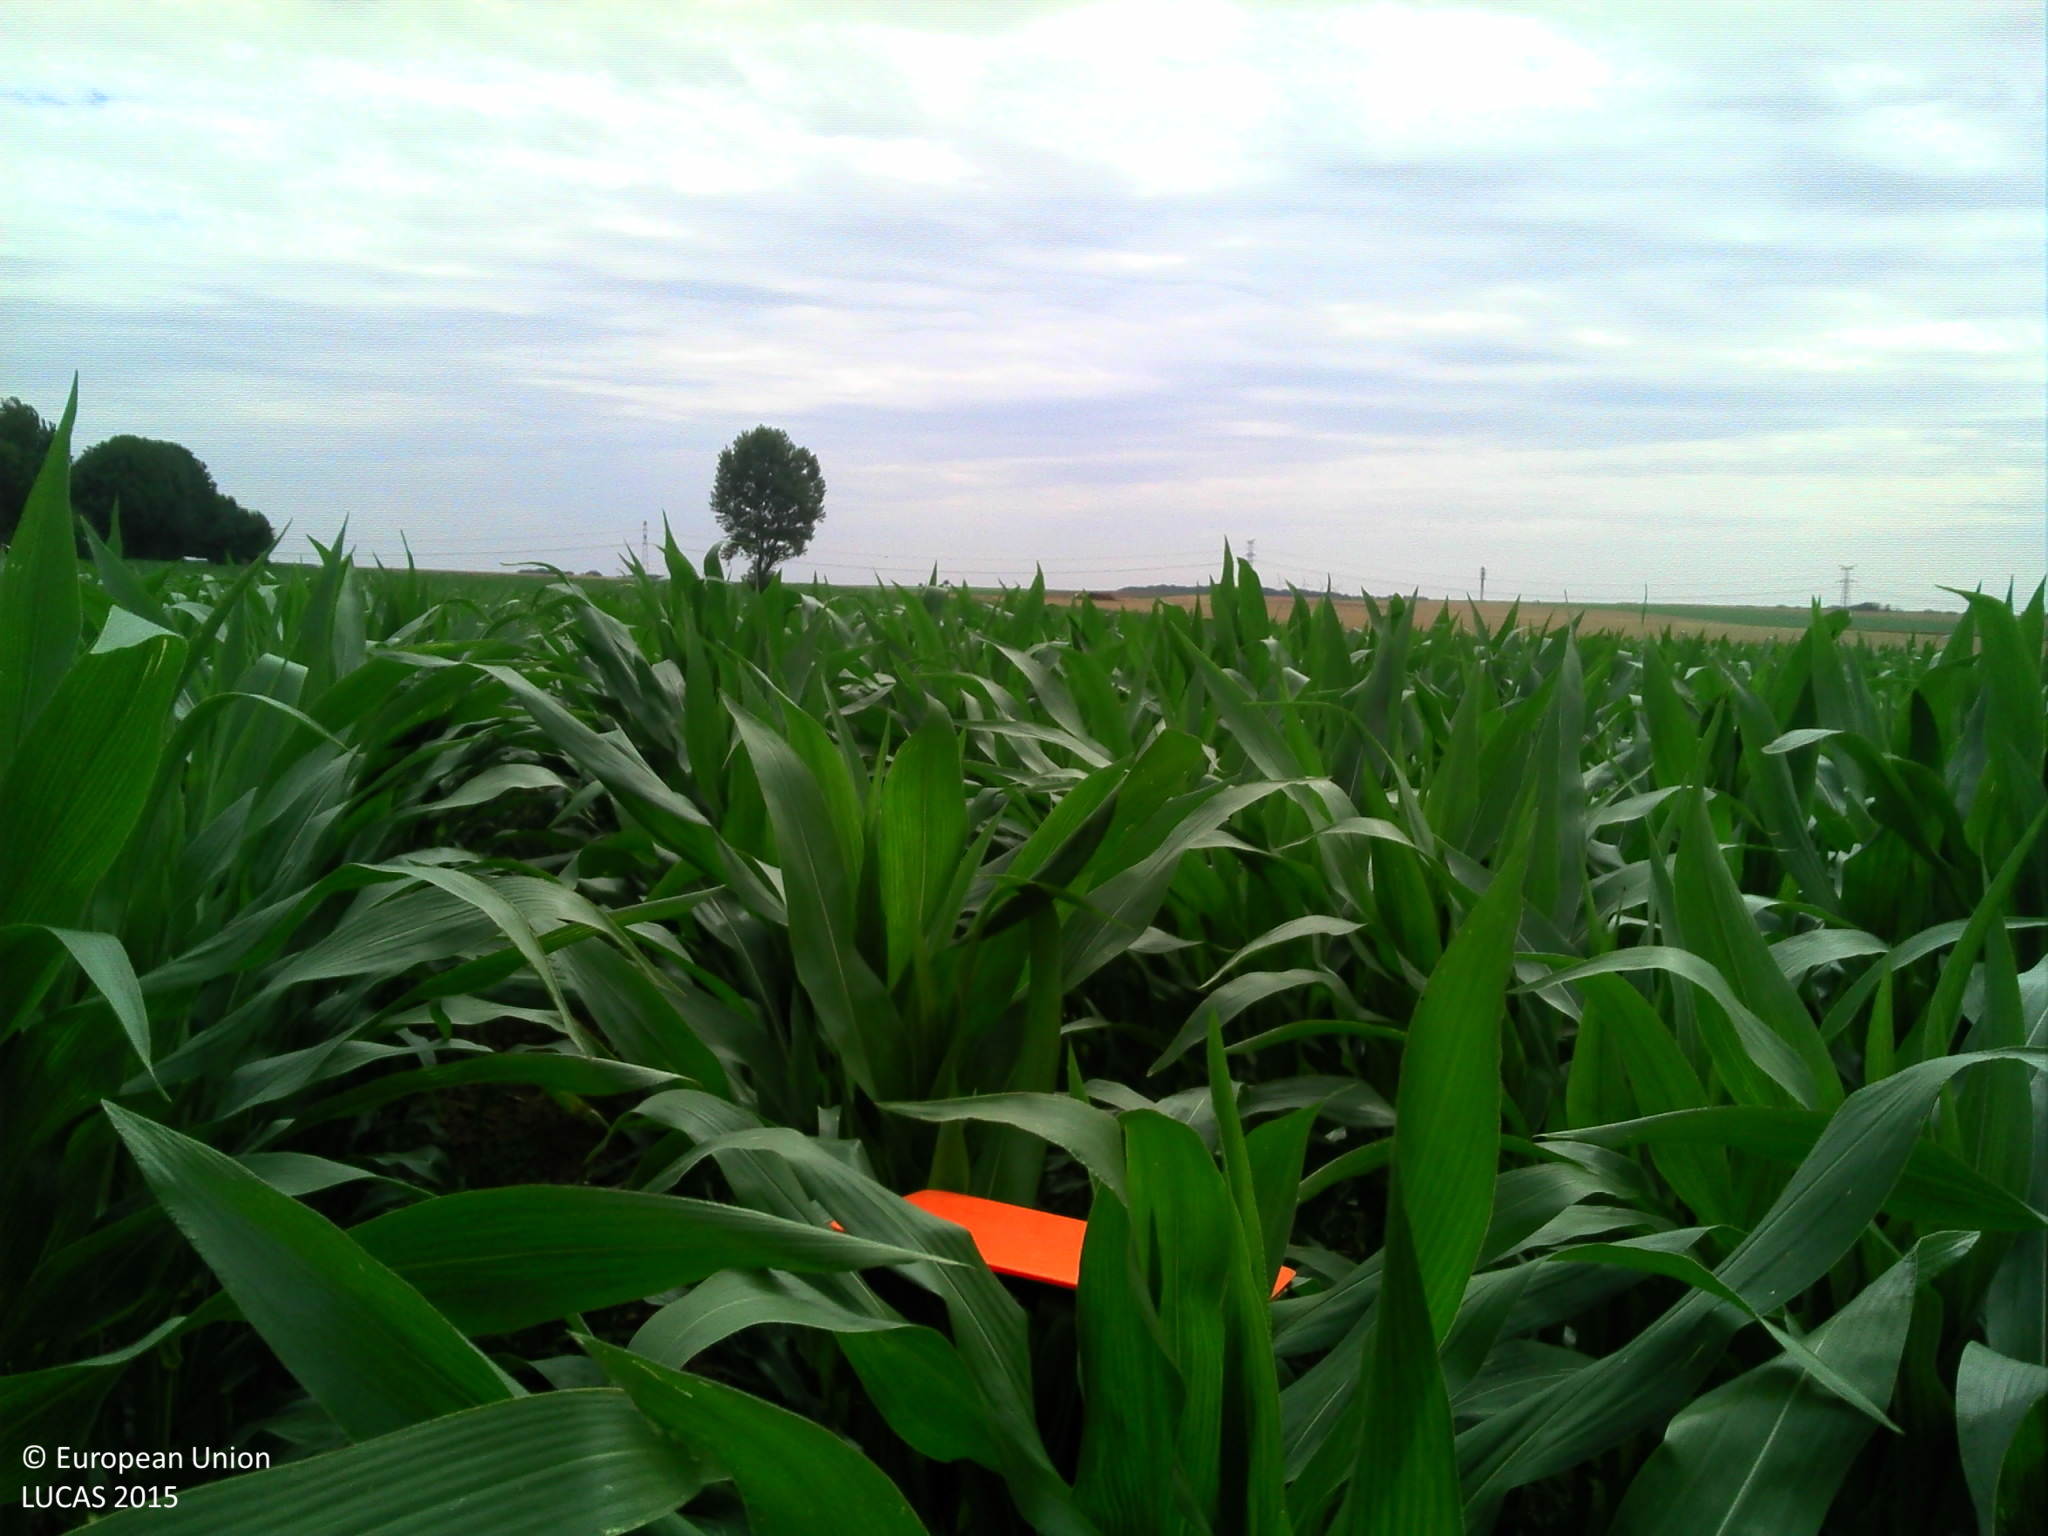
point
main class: Cropland
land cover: Maize
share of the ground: > 75 %
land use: Agriculture (excluding fallow land and kitchen gardens)
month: July
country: FR
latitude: 50.1491
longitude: 2.1625
